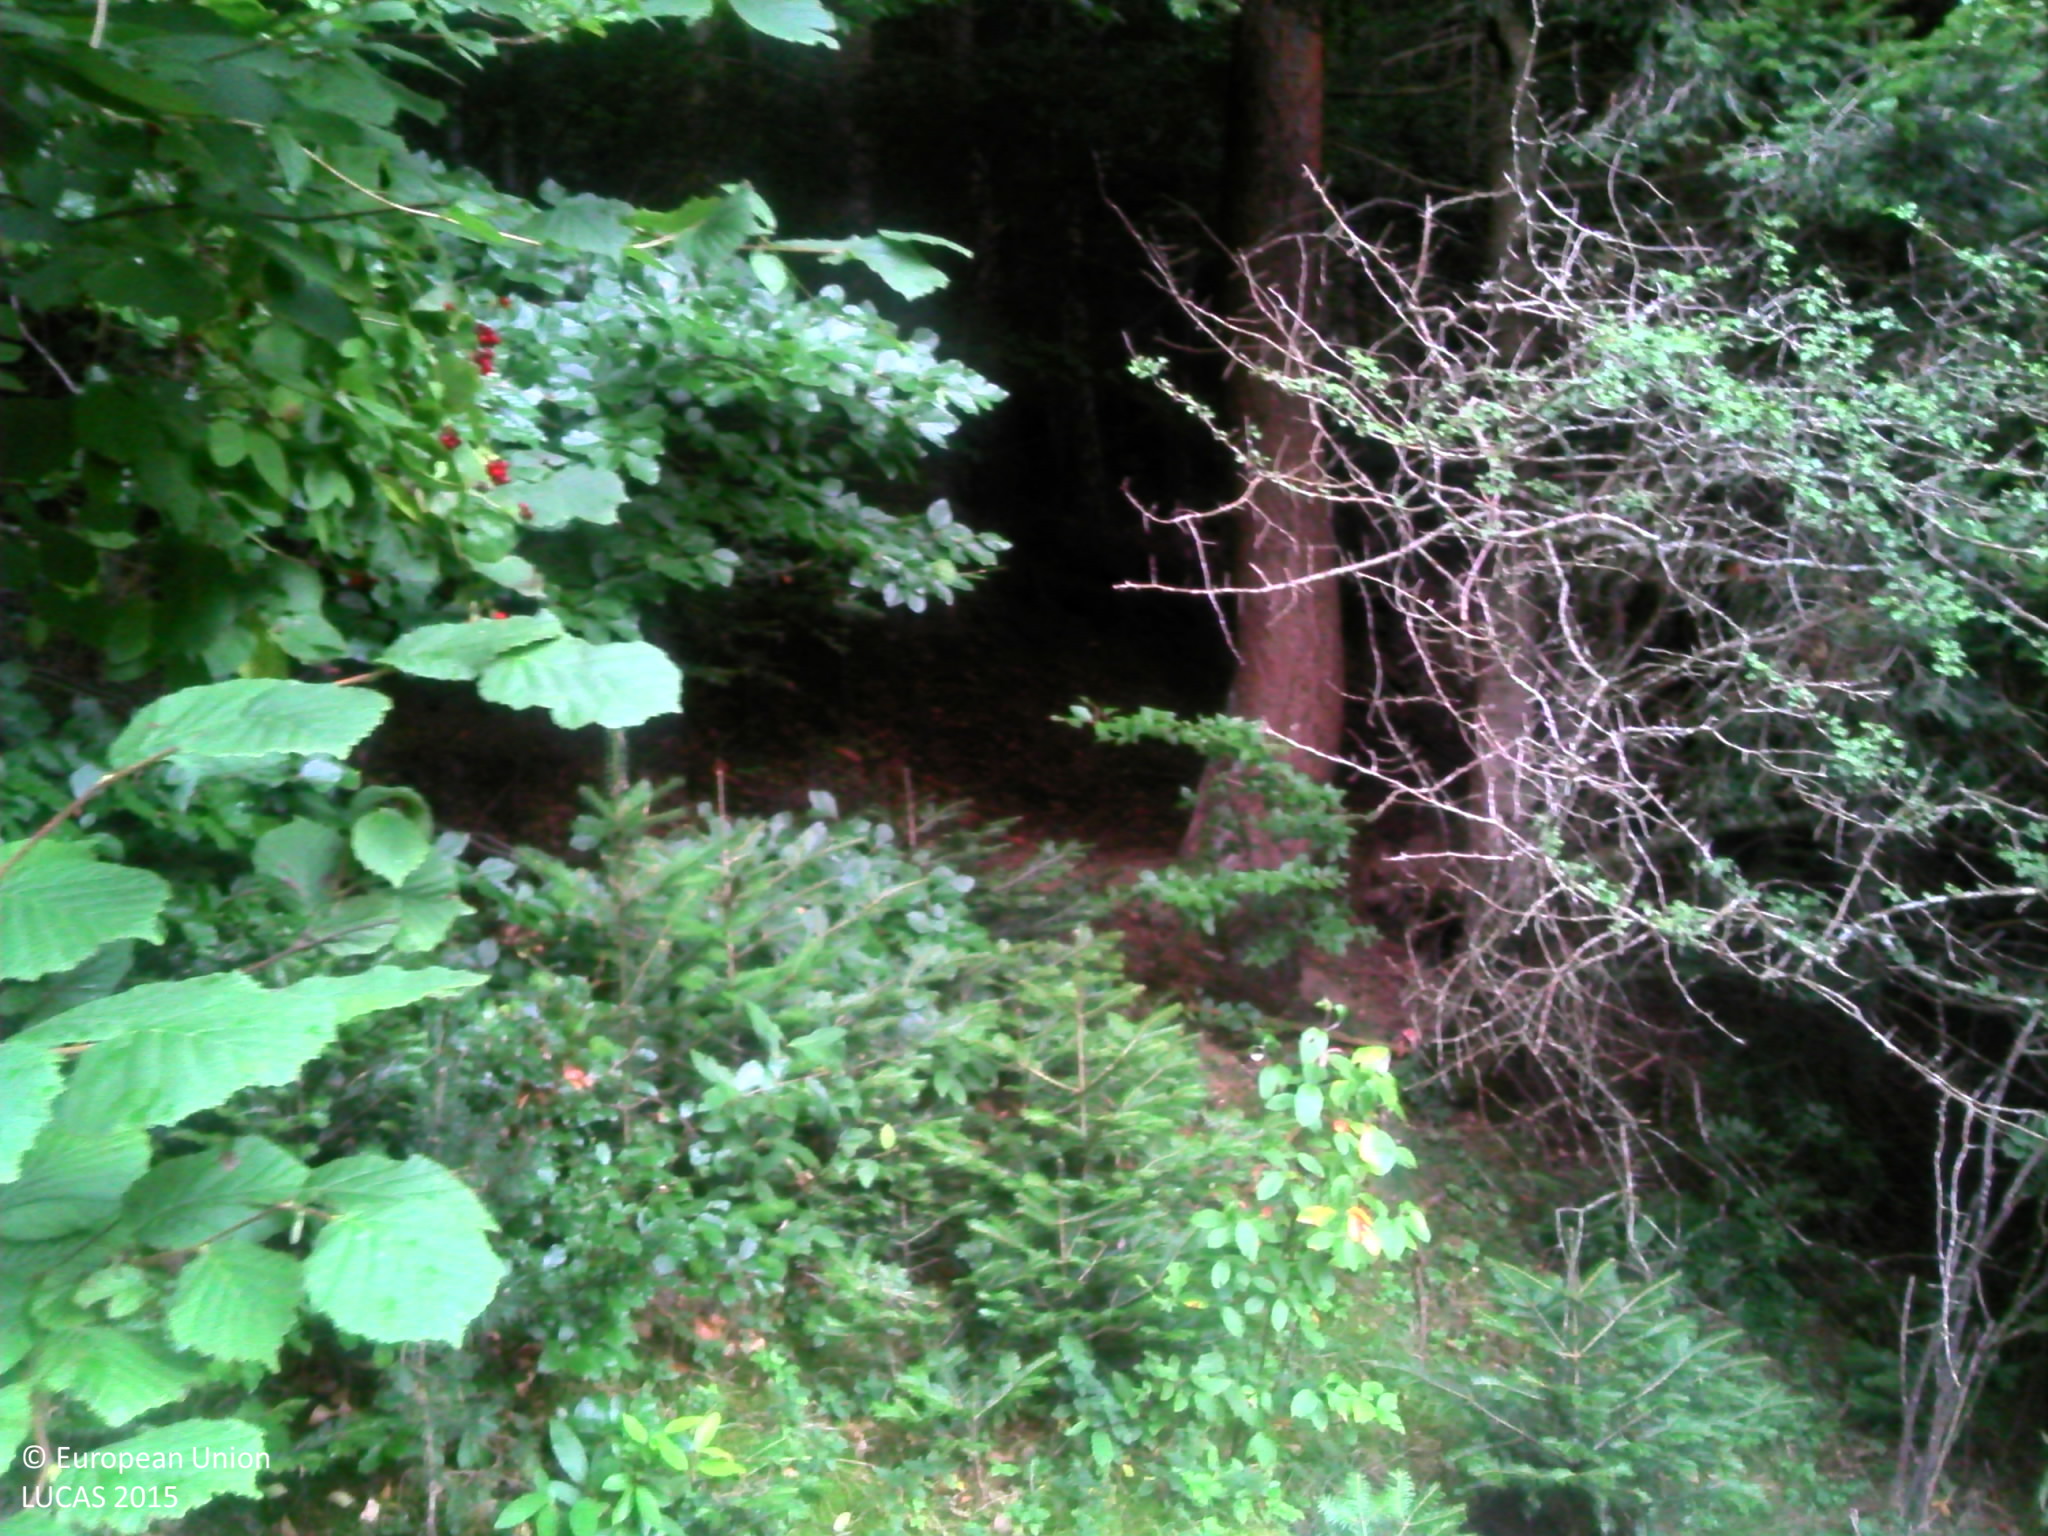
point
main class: Woodland
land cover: Spruce dominated mixed woodland
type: mountainous beech forest
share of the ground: > 75 %
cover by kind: coniferous forest trees 40 %, broadleaved forest trees 35 %, herbaceous plants 15 %, unconsolidated bare surface 10 %
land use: Forestry
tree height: > 5 m
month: August
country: FR
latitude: 45.2034
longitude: 4.5941
